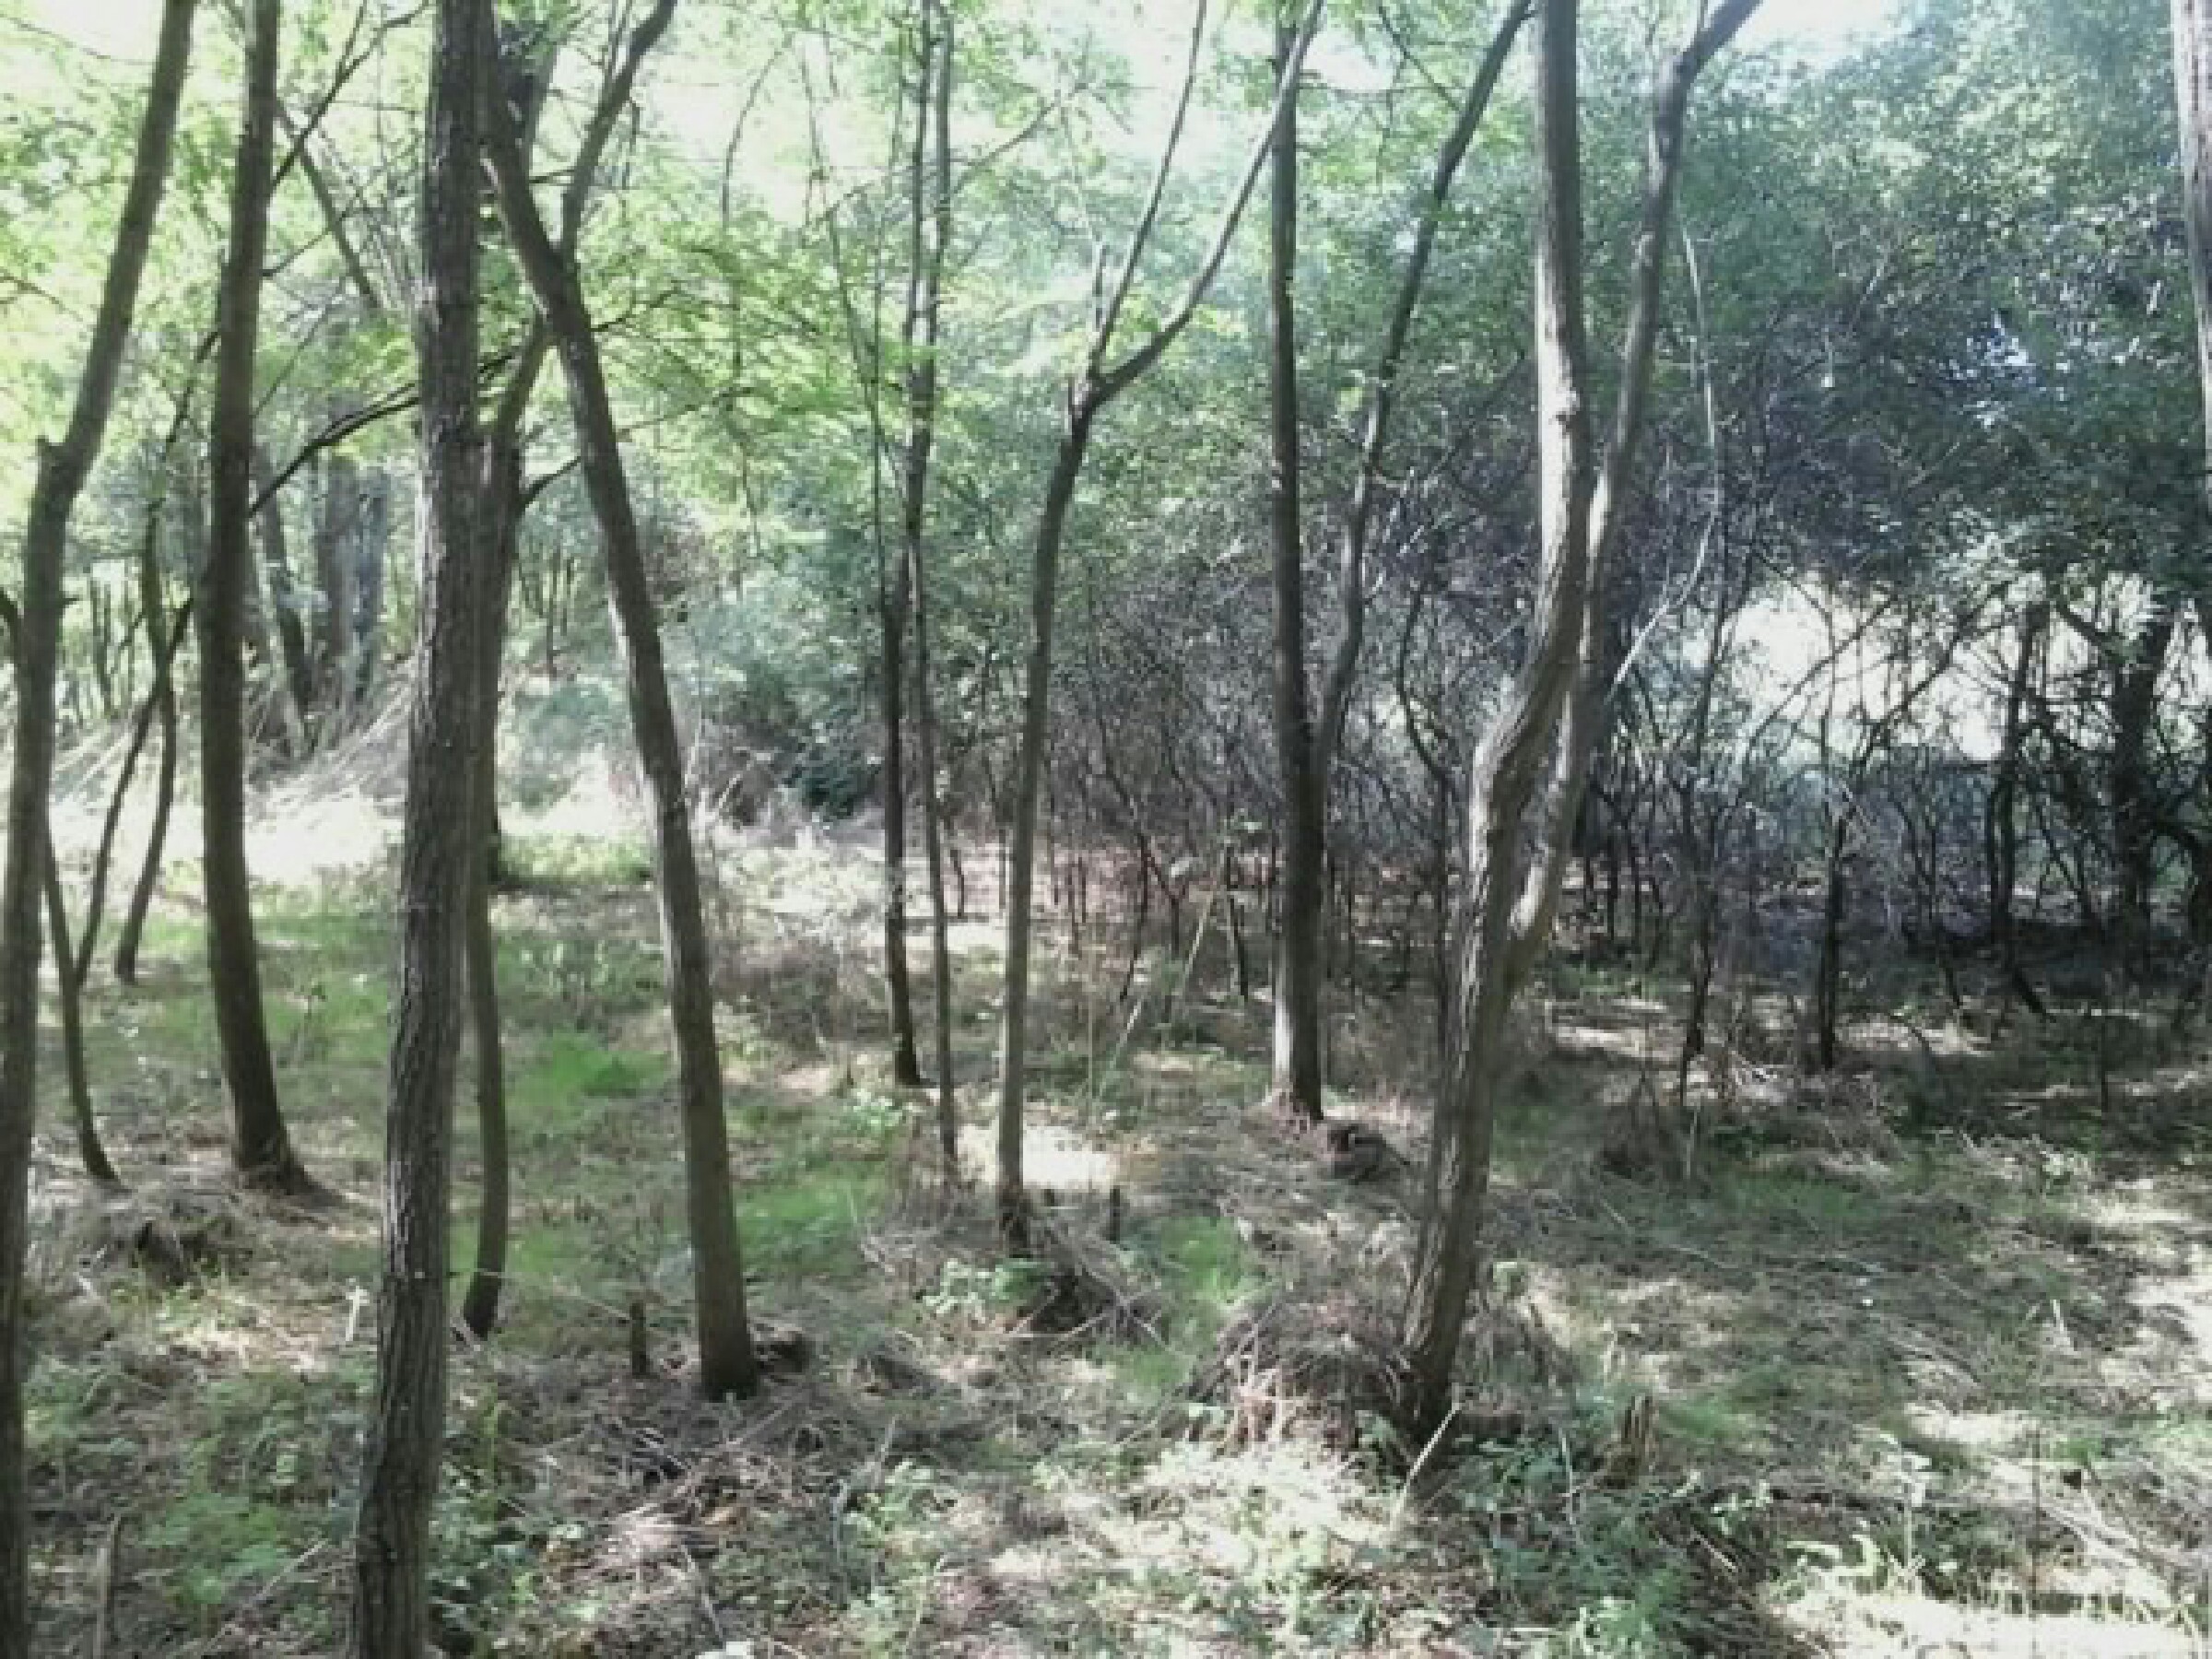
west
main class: Woodland
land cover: Broadleaved woodland
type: exotic forest
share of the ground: > 75 %
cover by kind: broadleaved forest trees 100 %
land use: Forestry
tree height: > 5 m
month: August
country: HU
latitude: 47.9317
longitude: 19.3781
